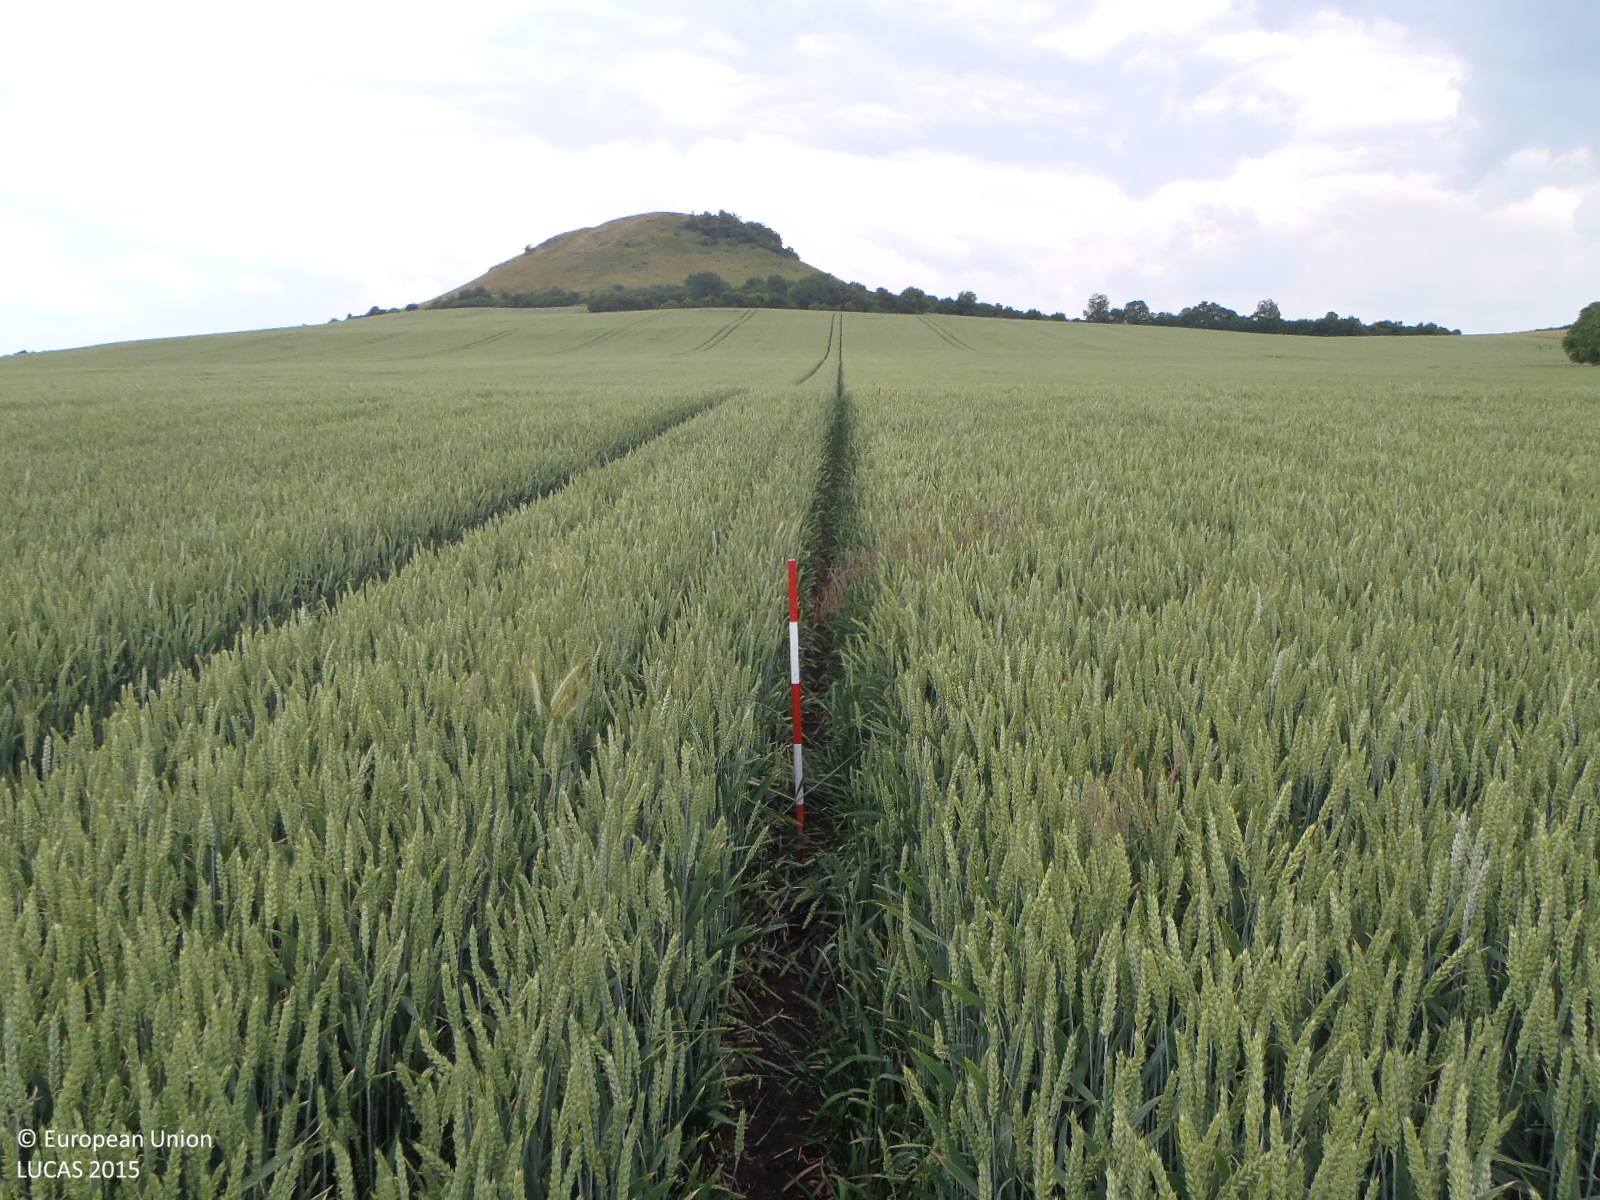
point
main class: Cropland
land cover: Common wheat
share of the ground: > 75 %
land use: Agriculture (excluding fallow land and kitchen gardens)
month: June
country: CZ
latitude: 50.4614
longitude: 13.8465
